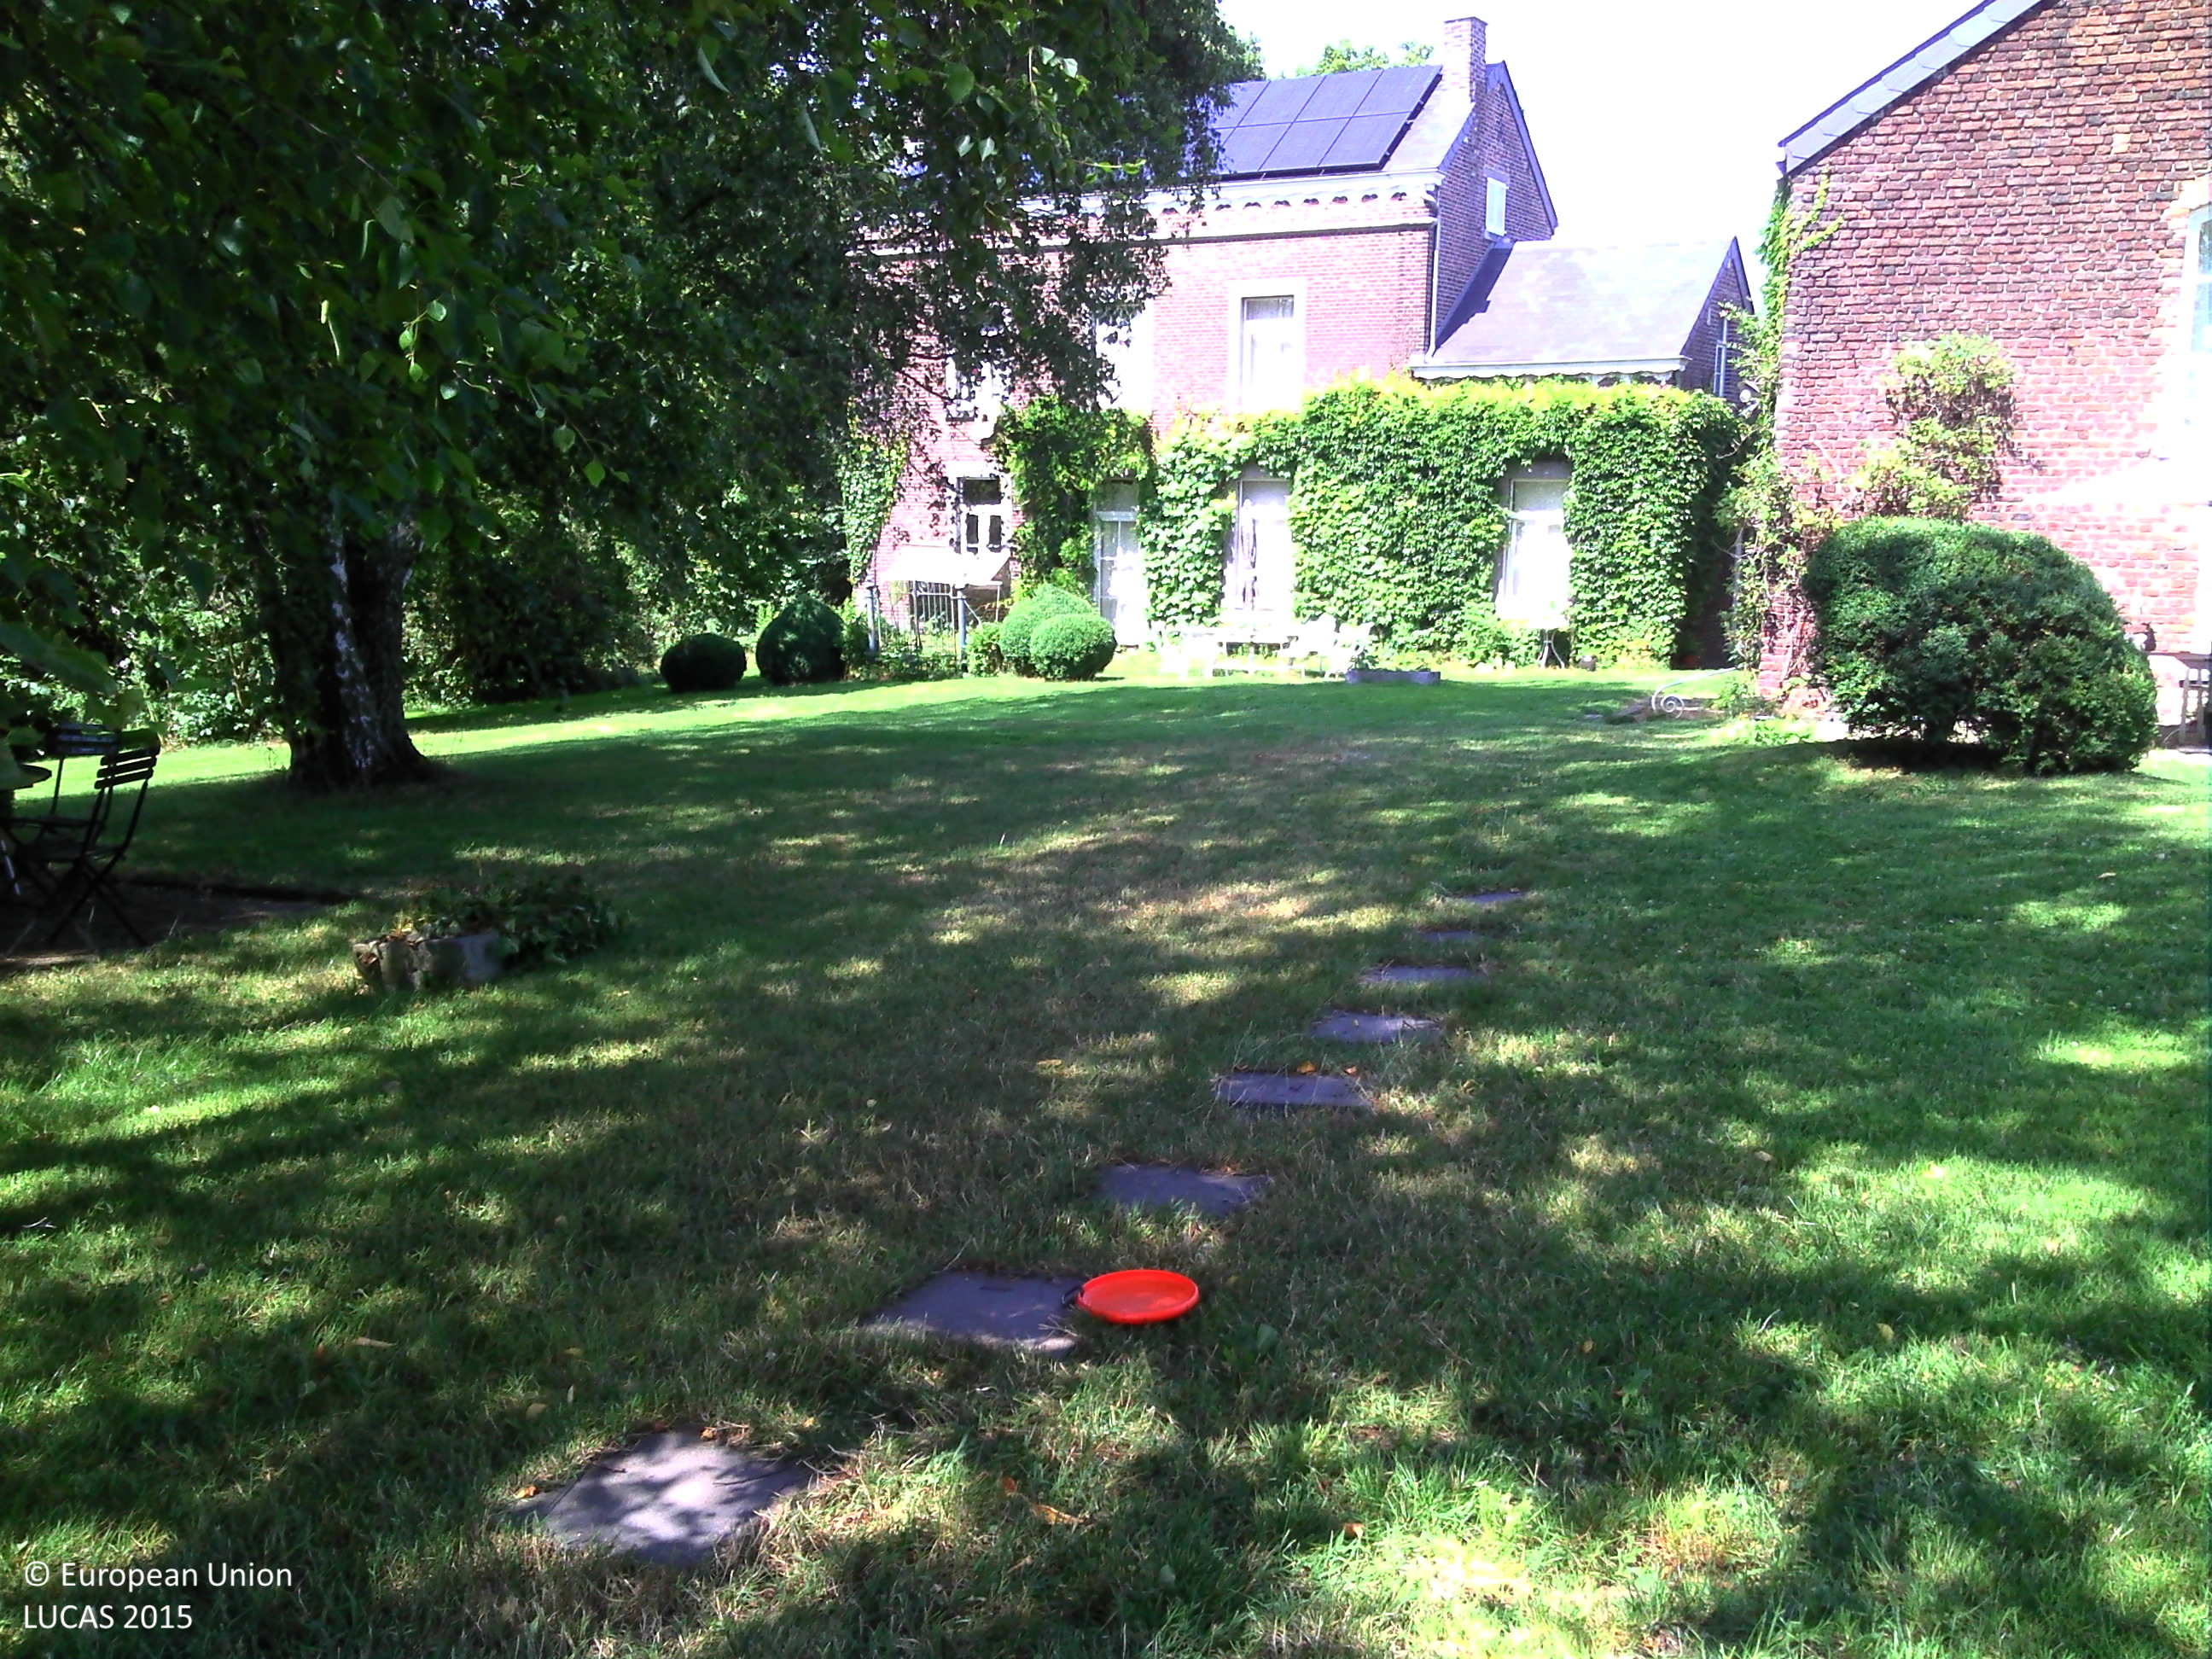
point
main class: Grassland
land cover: Grassland with sparse tree/shrub cover
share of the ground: > 75 %
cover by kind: herbaceous plants 95 %, broadleaved forest trees 5 %
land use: Residential
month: July
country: BE
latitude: 50.6428
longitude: 5.6855
